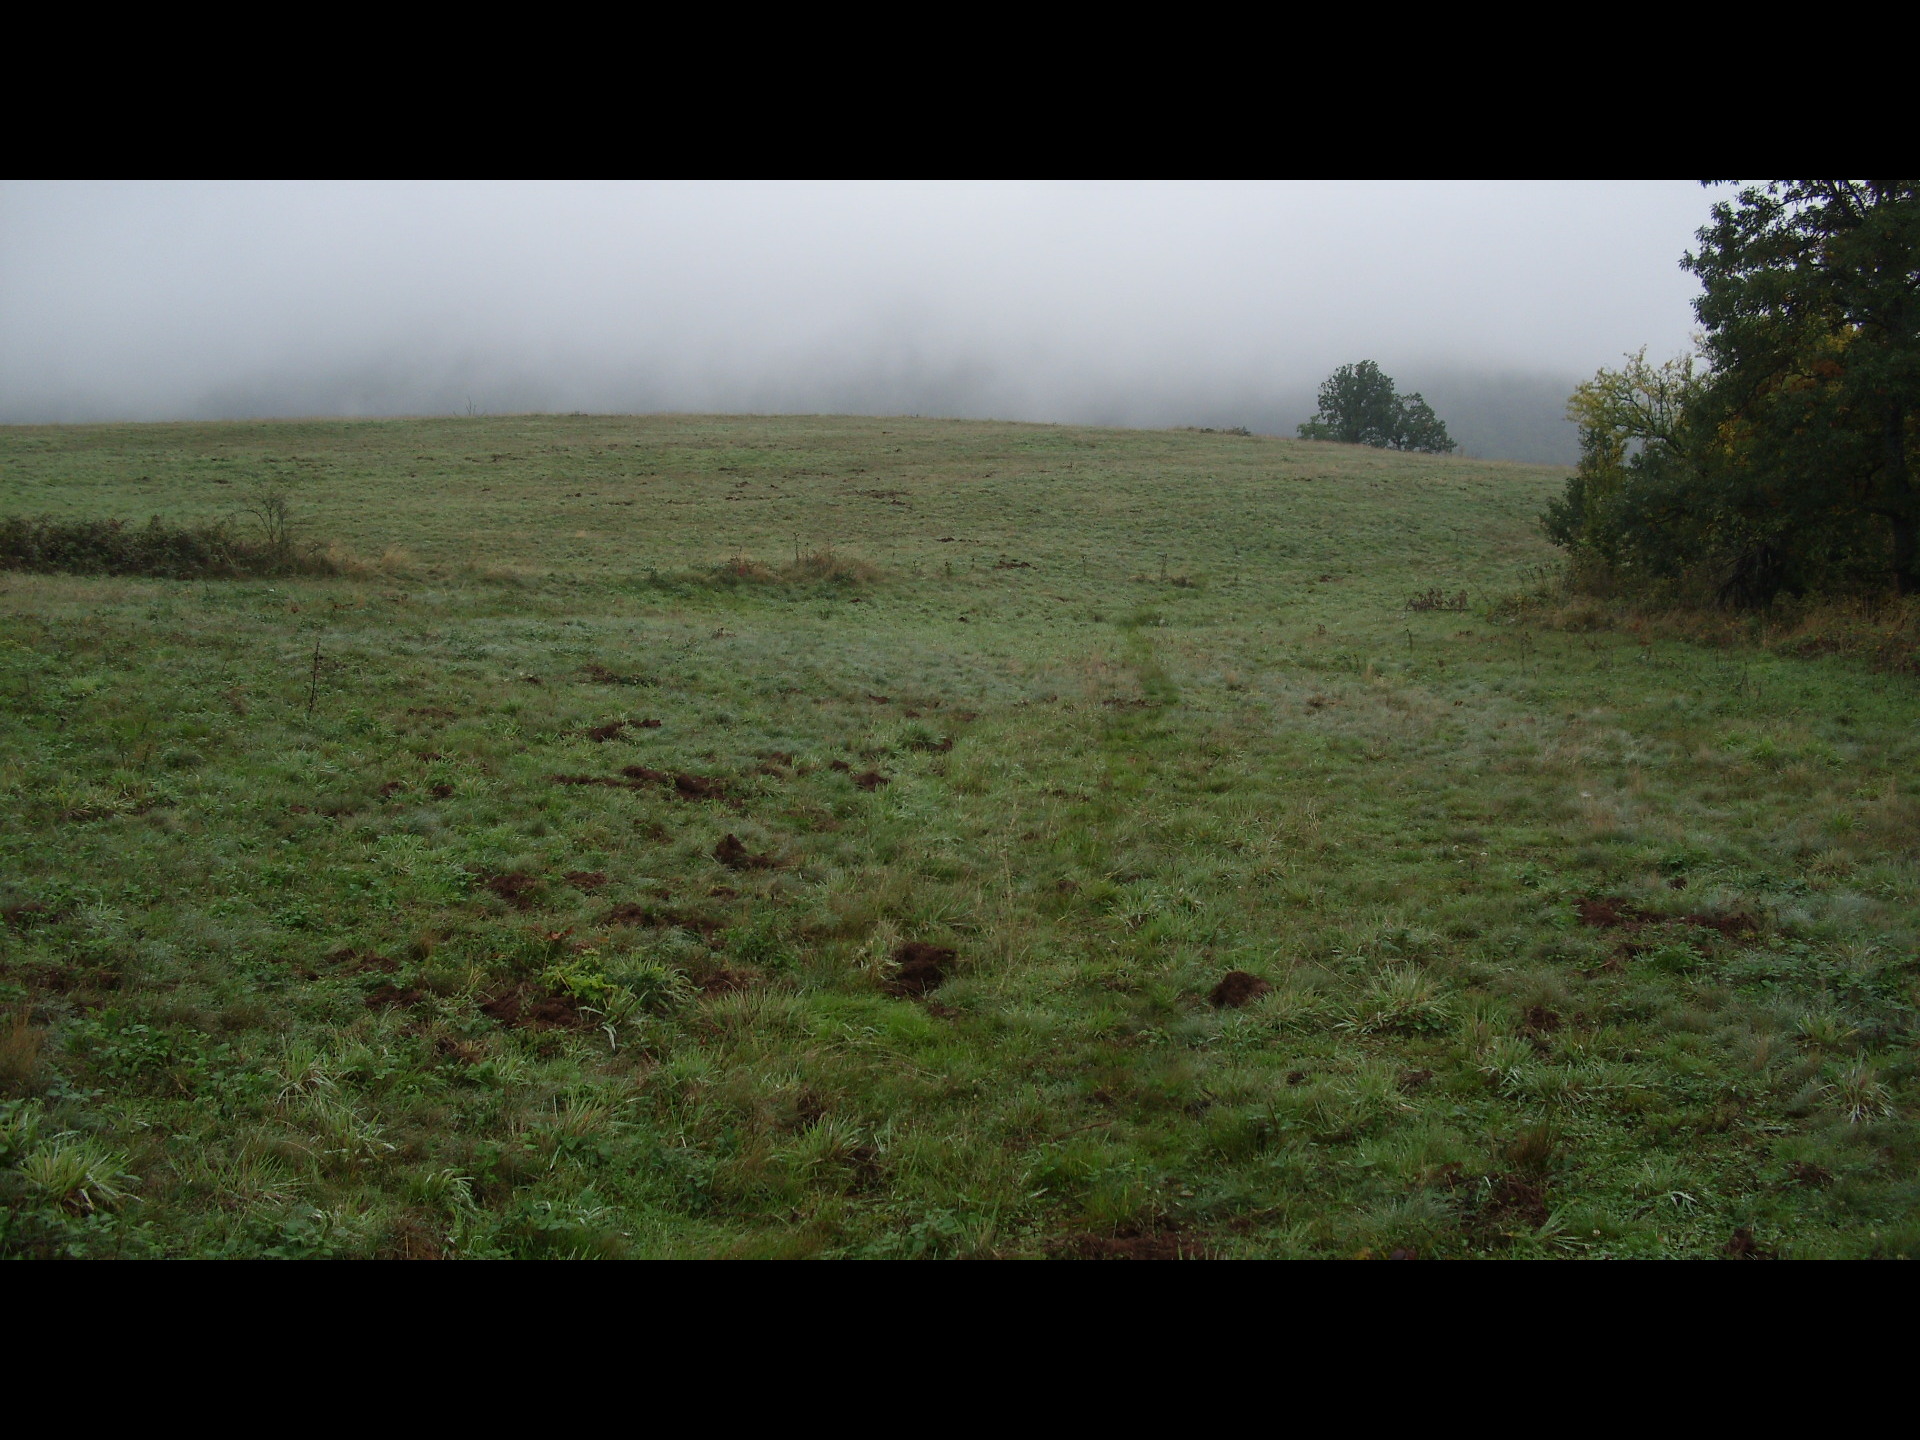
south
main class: Grassland
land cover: Grassland without tree/shrub cover
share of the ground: > 75 %
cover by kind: herbaceous plants 95 %, unconsolidated bare surface 5 %
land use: Agriculture (excluding fallow land and kitchen gardens)
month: October
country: BG
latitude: 43.5191
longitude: 22.7893
